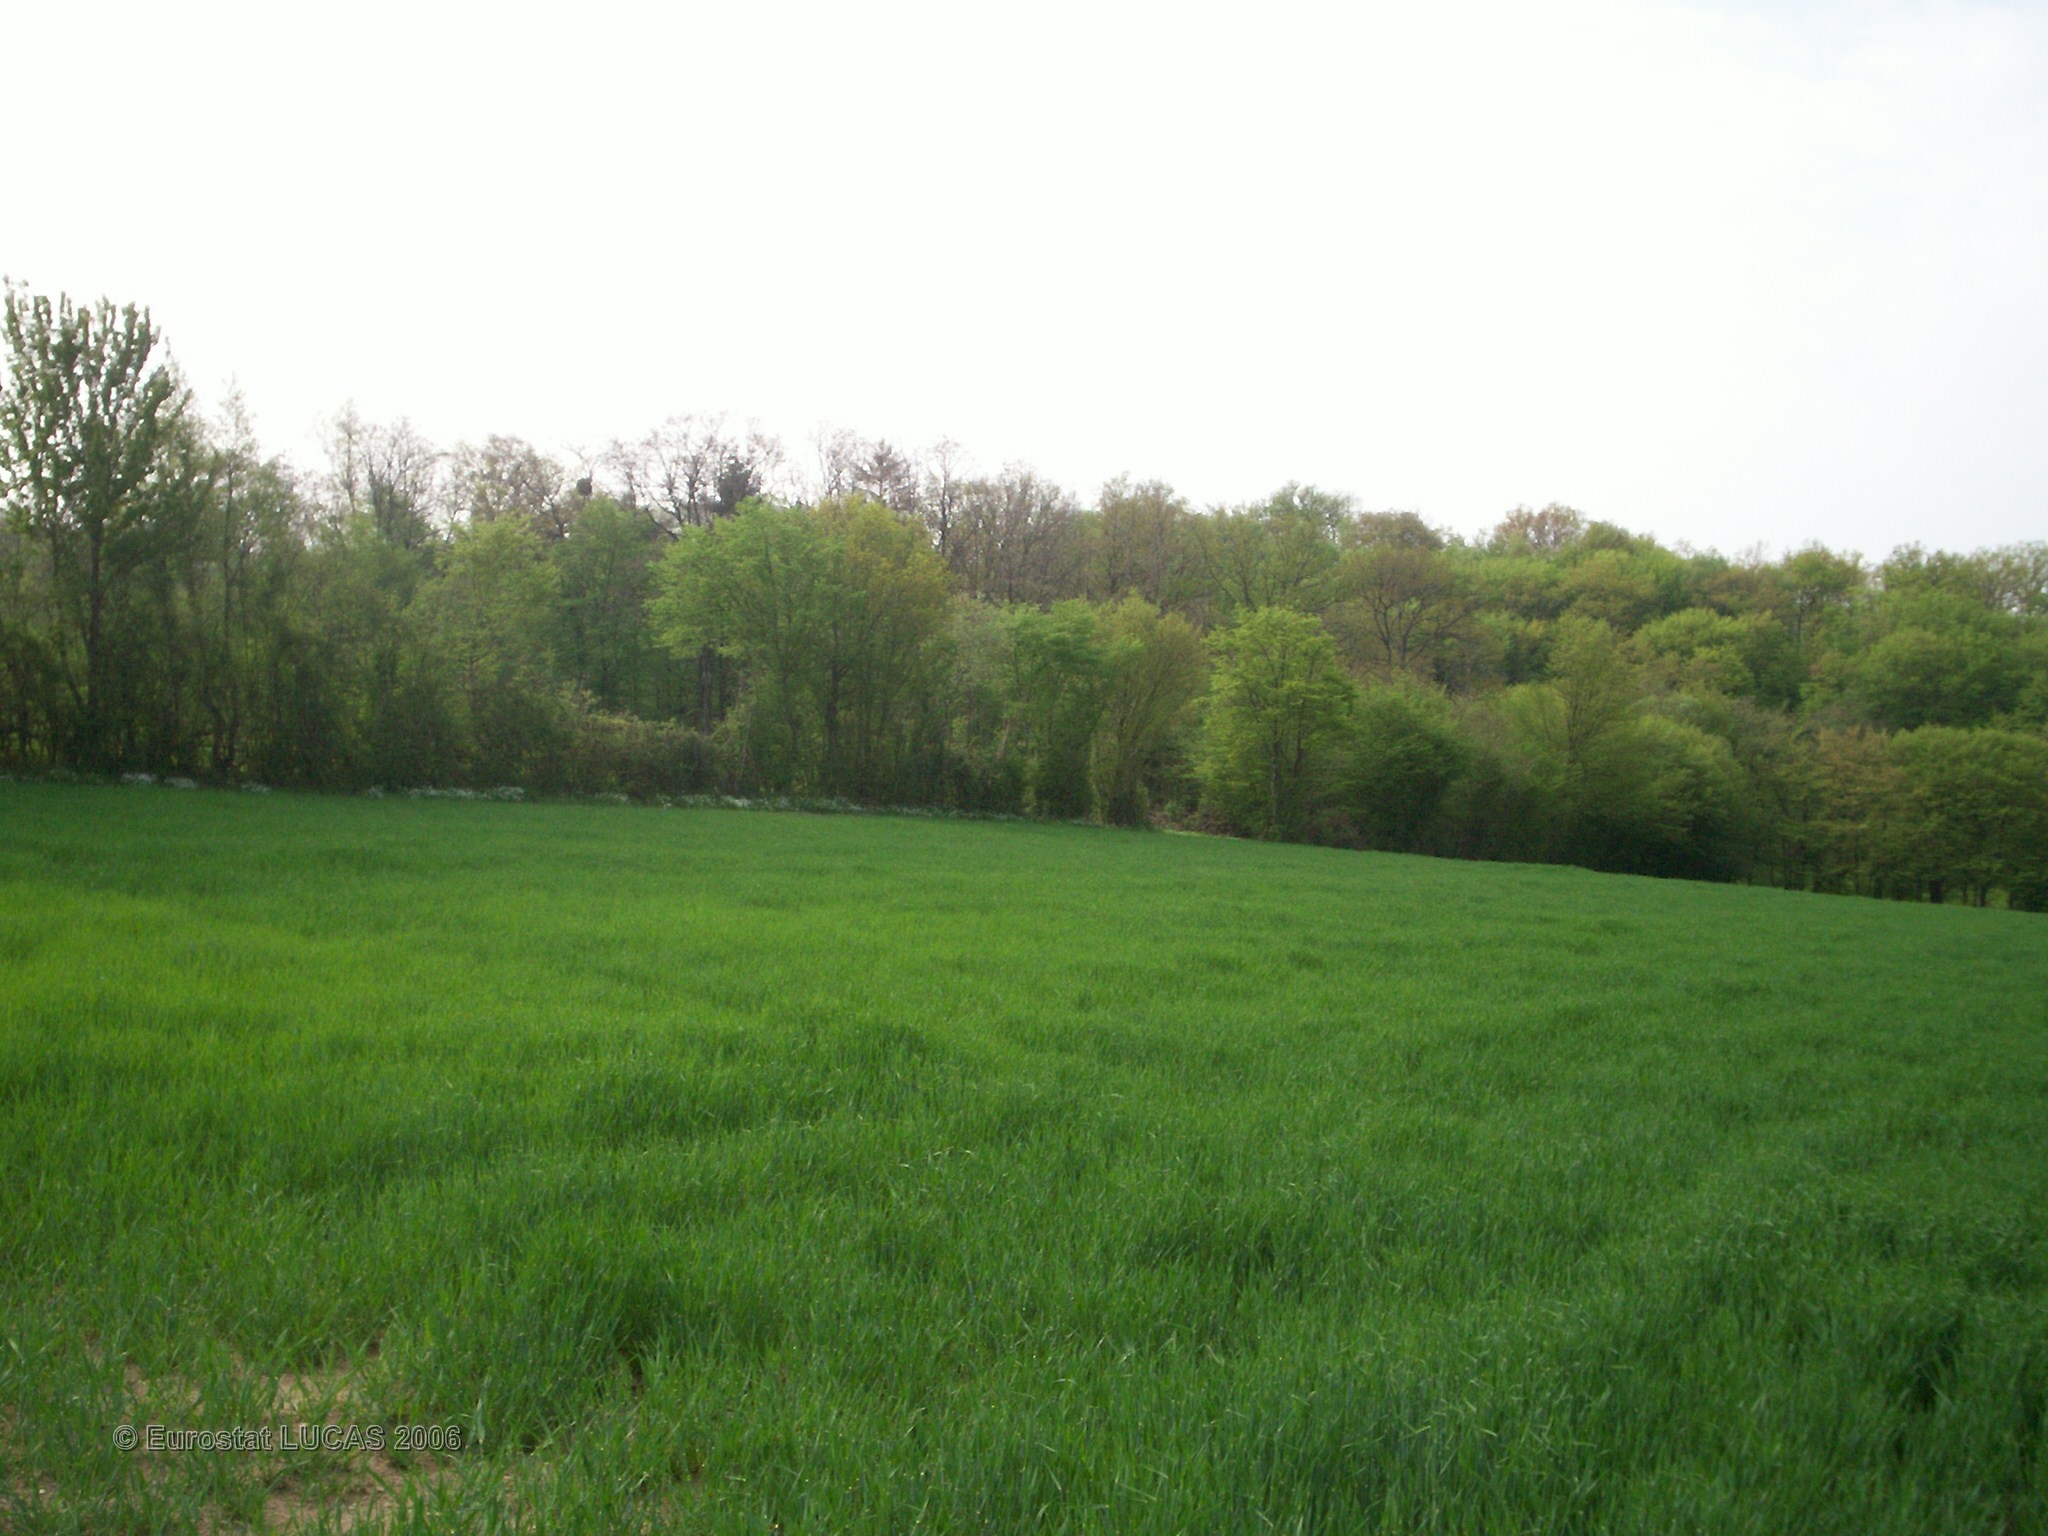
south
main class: Cropland
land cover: Barley
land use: Agriculture (excluding fallow land and kitchen gardens)
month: May
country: FR
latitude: 47.4295
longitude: 4.0189
